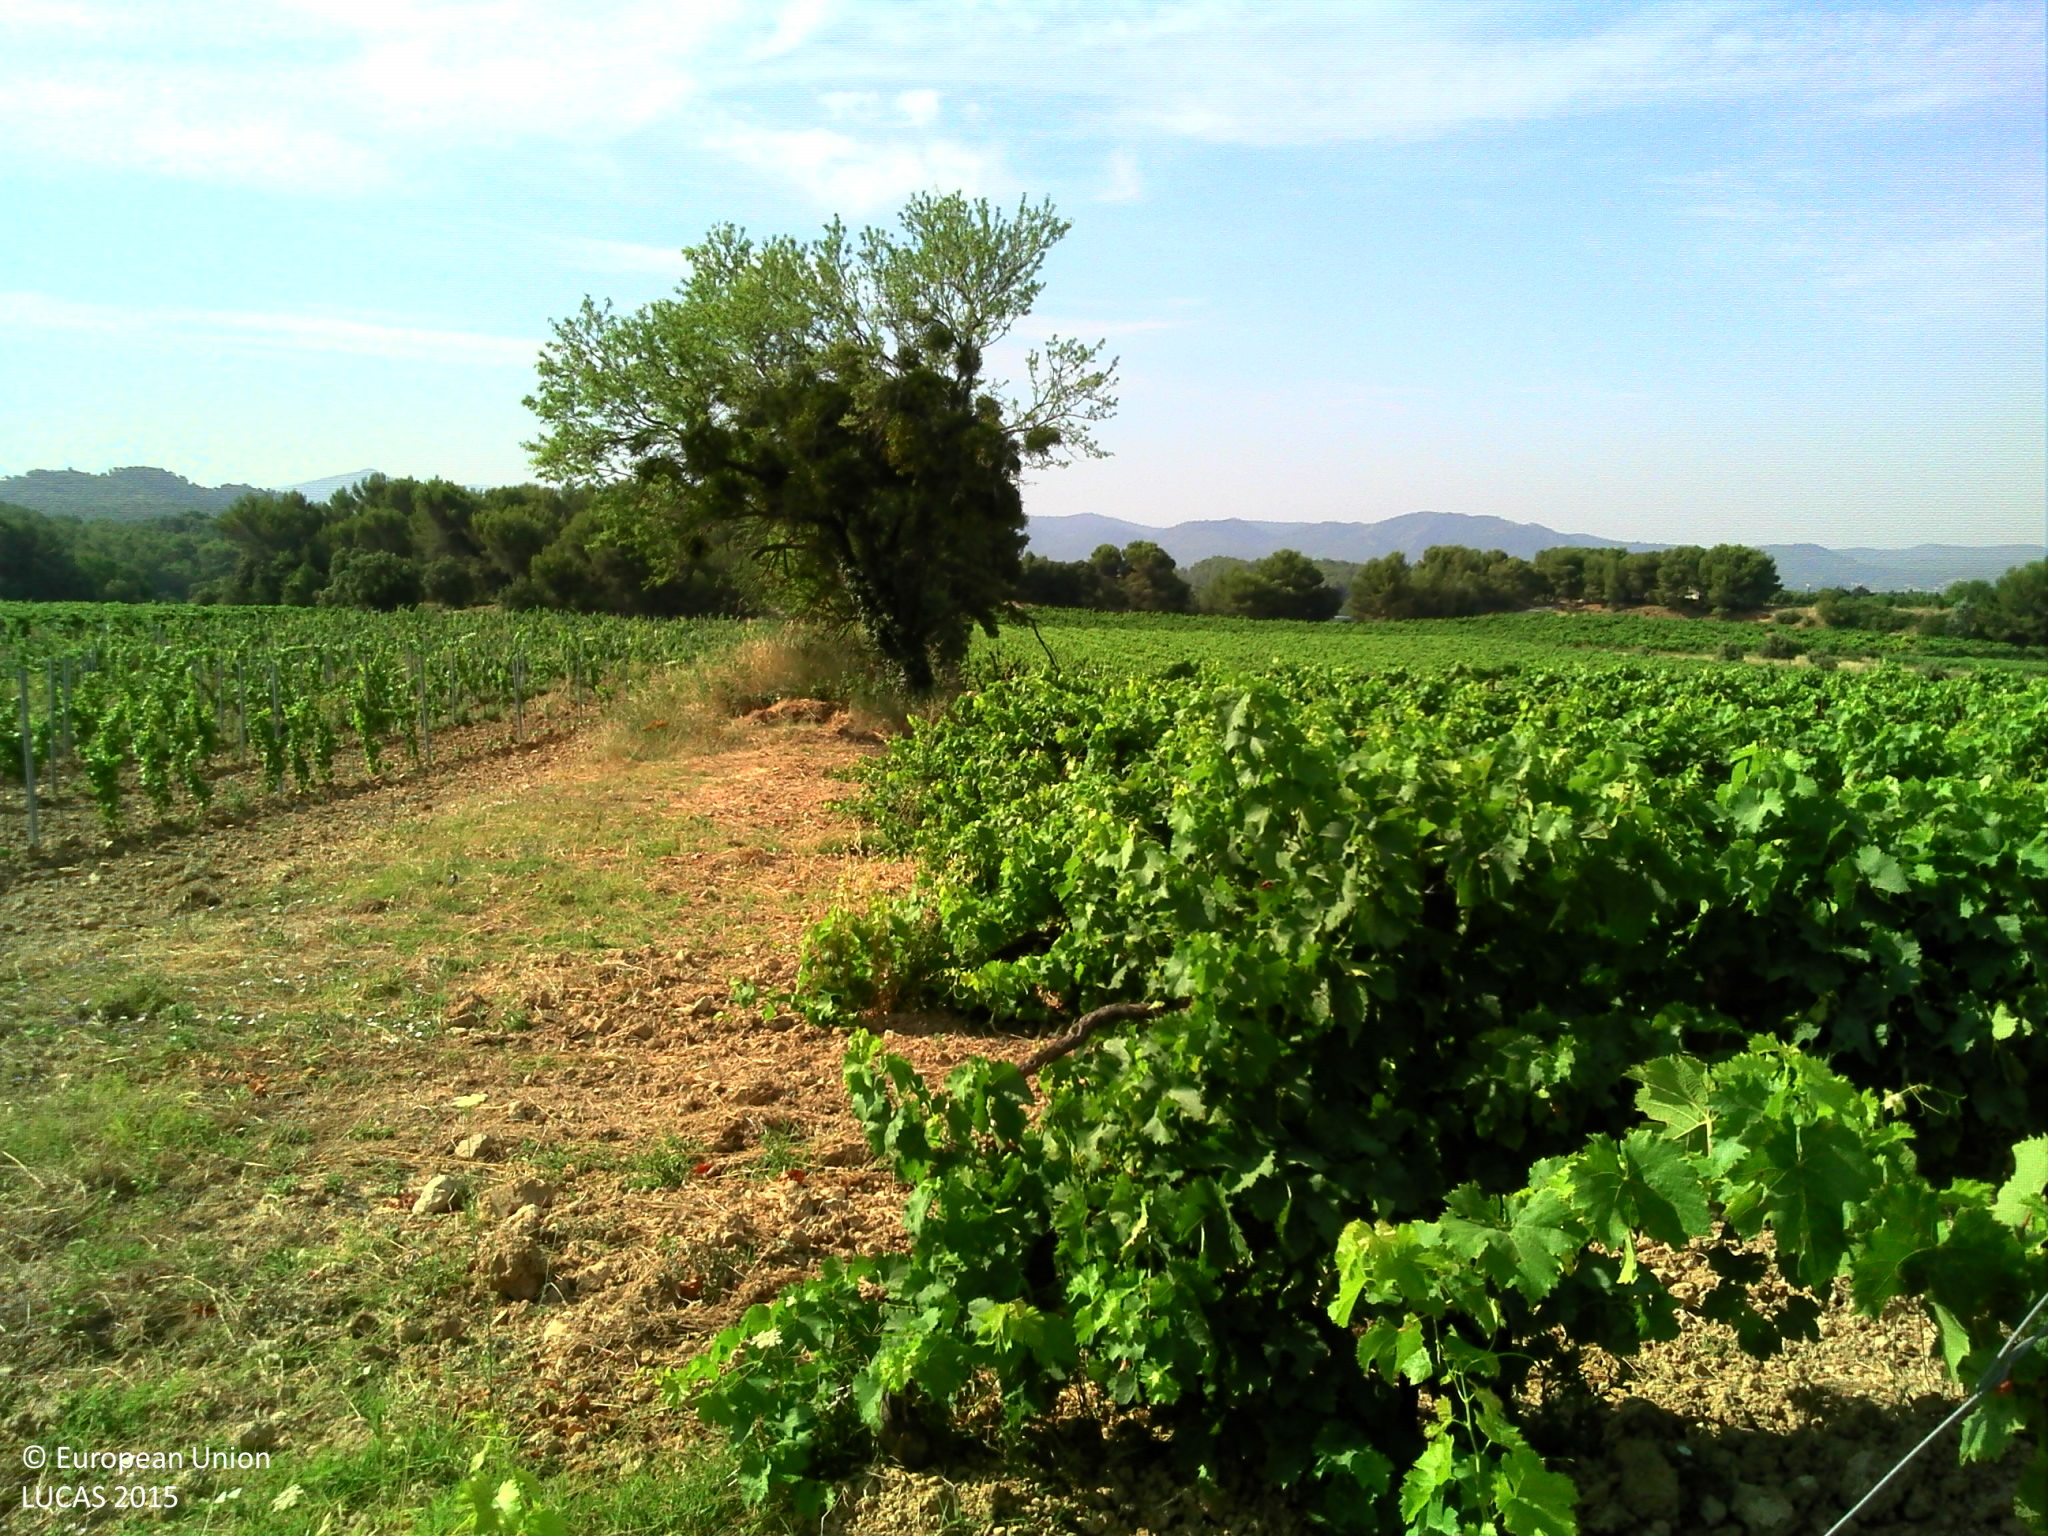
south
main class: Cropland
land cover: Vineyards
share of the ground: 25 - 50 %
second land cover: Other bare soil
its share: > 75 %
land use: Agriculture (excluding fallow land and kitchen gardens)
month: July
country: FR
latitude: 43.6953
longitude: 5.5548
